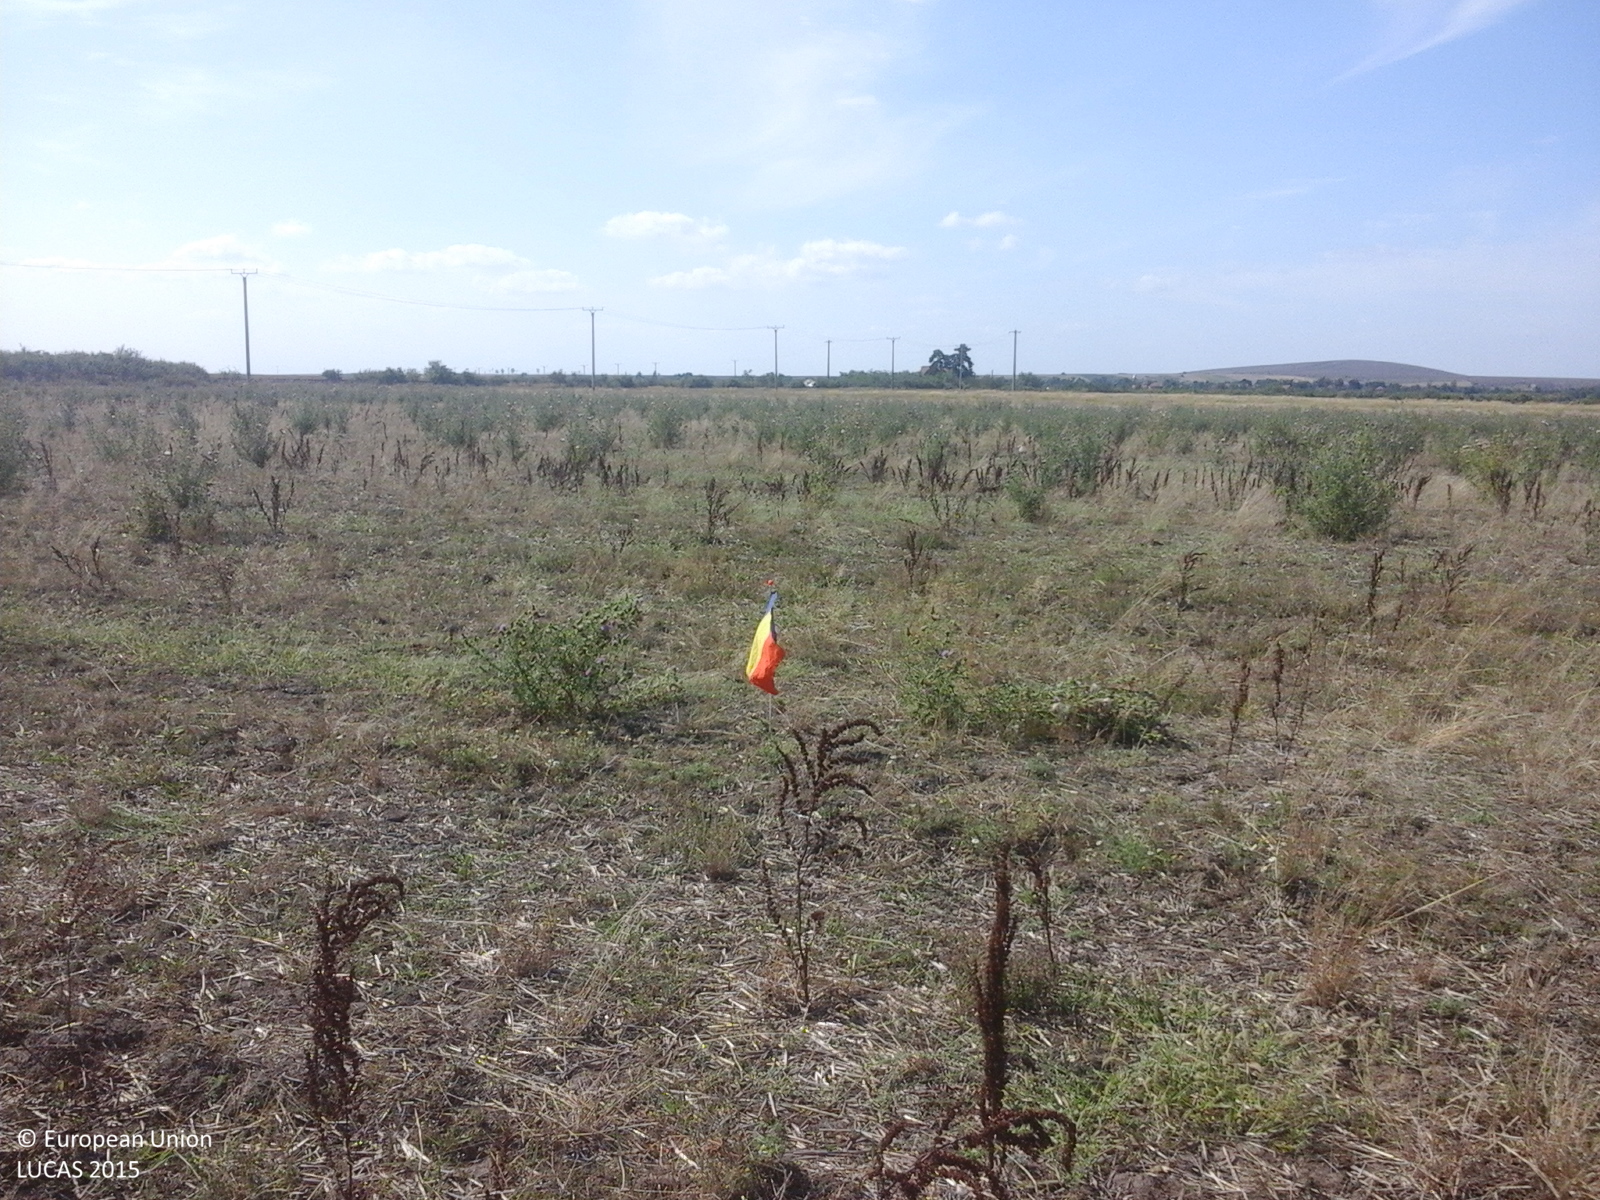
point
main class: Grassland
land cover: Spontaneously vegetated surfaces
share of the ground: > 75 %
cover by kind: herbaceous plants 100 %
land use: Fallow land
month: August
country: RO
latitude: 45.3517
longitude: 21.4548
